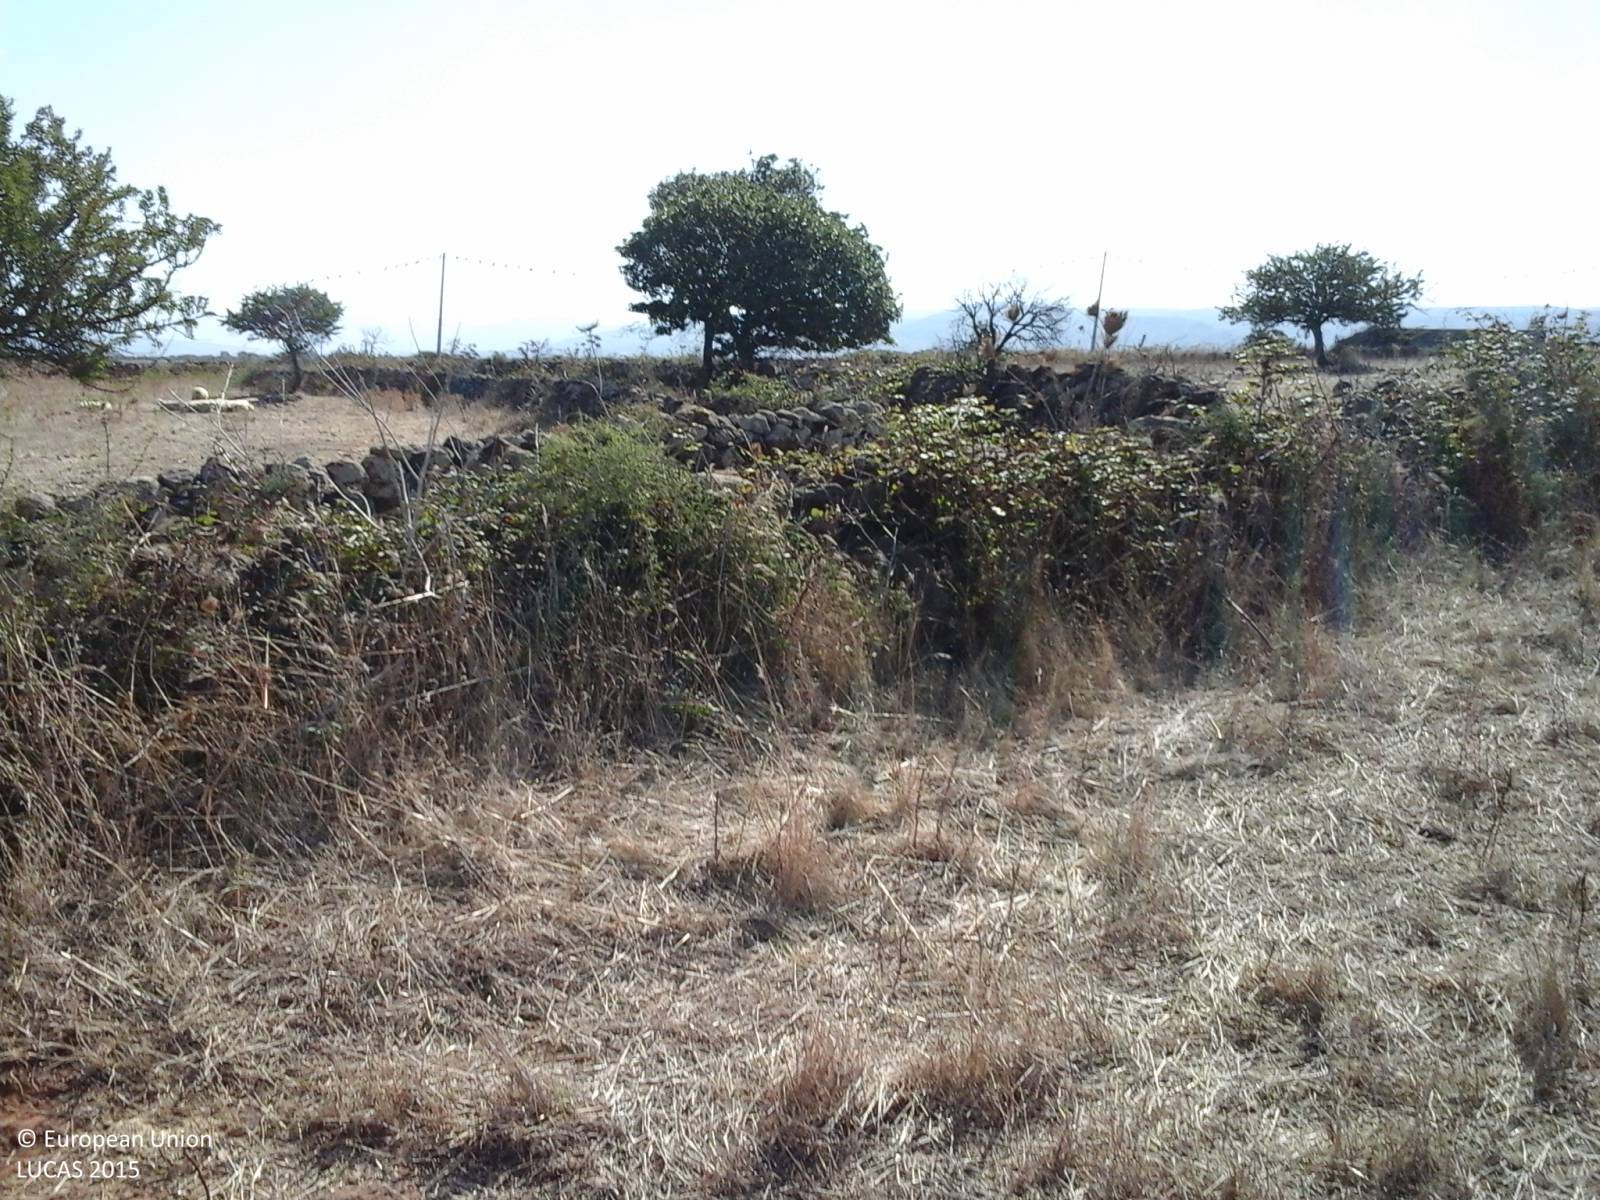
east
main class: Grassland
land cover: Grassland without tree/shrub cover
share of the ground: 25 - 50 %
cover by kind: herbaceous plants 100 %
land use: Agriculture (excluding fallow land and kitchen gardens)
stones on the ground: 25 - 50 %
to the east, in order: Grassland without tree/shrub cover; Dry stone walls; Tracks; Grassland without tree/shrub cover; Dry stone walls; Tracks; Dry stone walls; Grassland without tree/shrub cover; Dry stone walls; Tracks; Electric lines; Dry stone walls; Grassland without tree/shrub cover
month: August
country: IT
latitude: 40.1157
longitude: 8.8446
